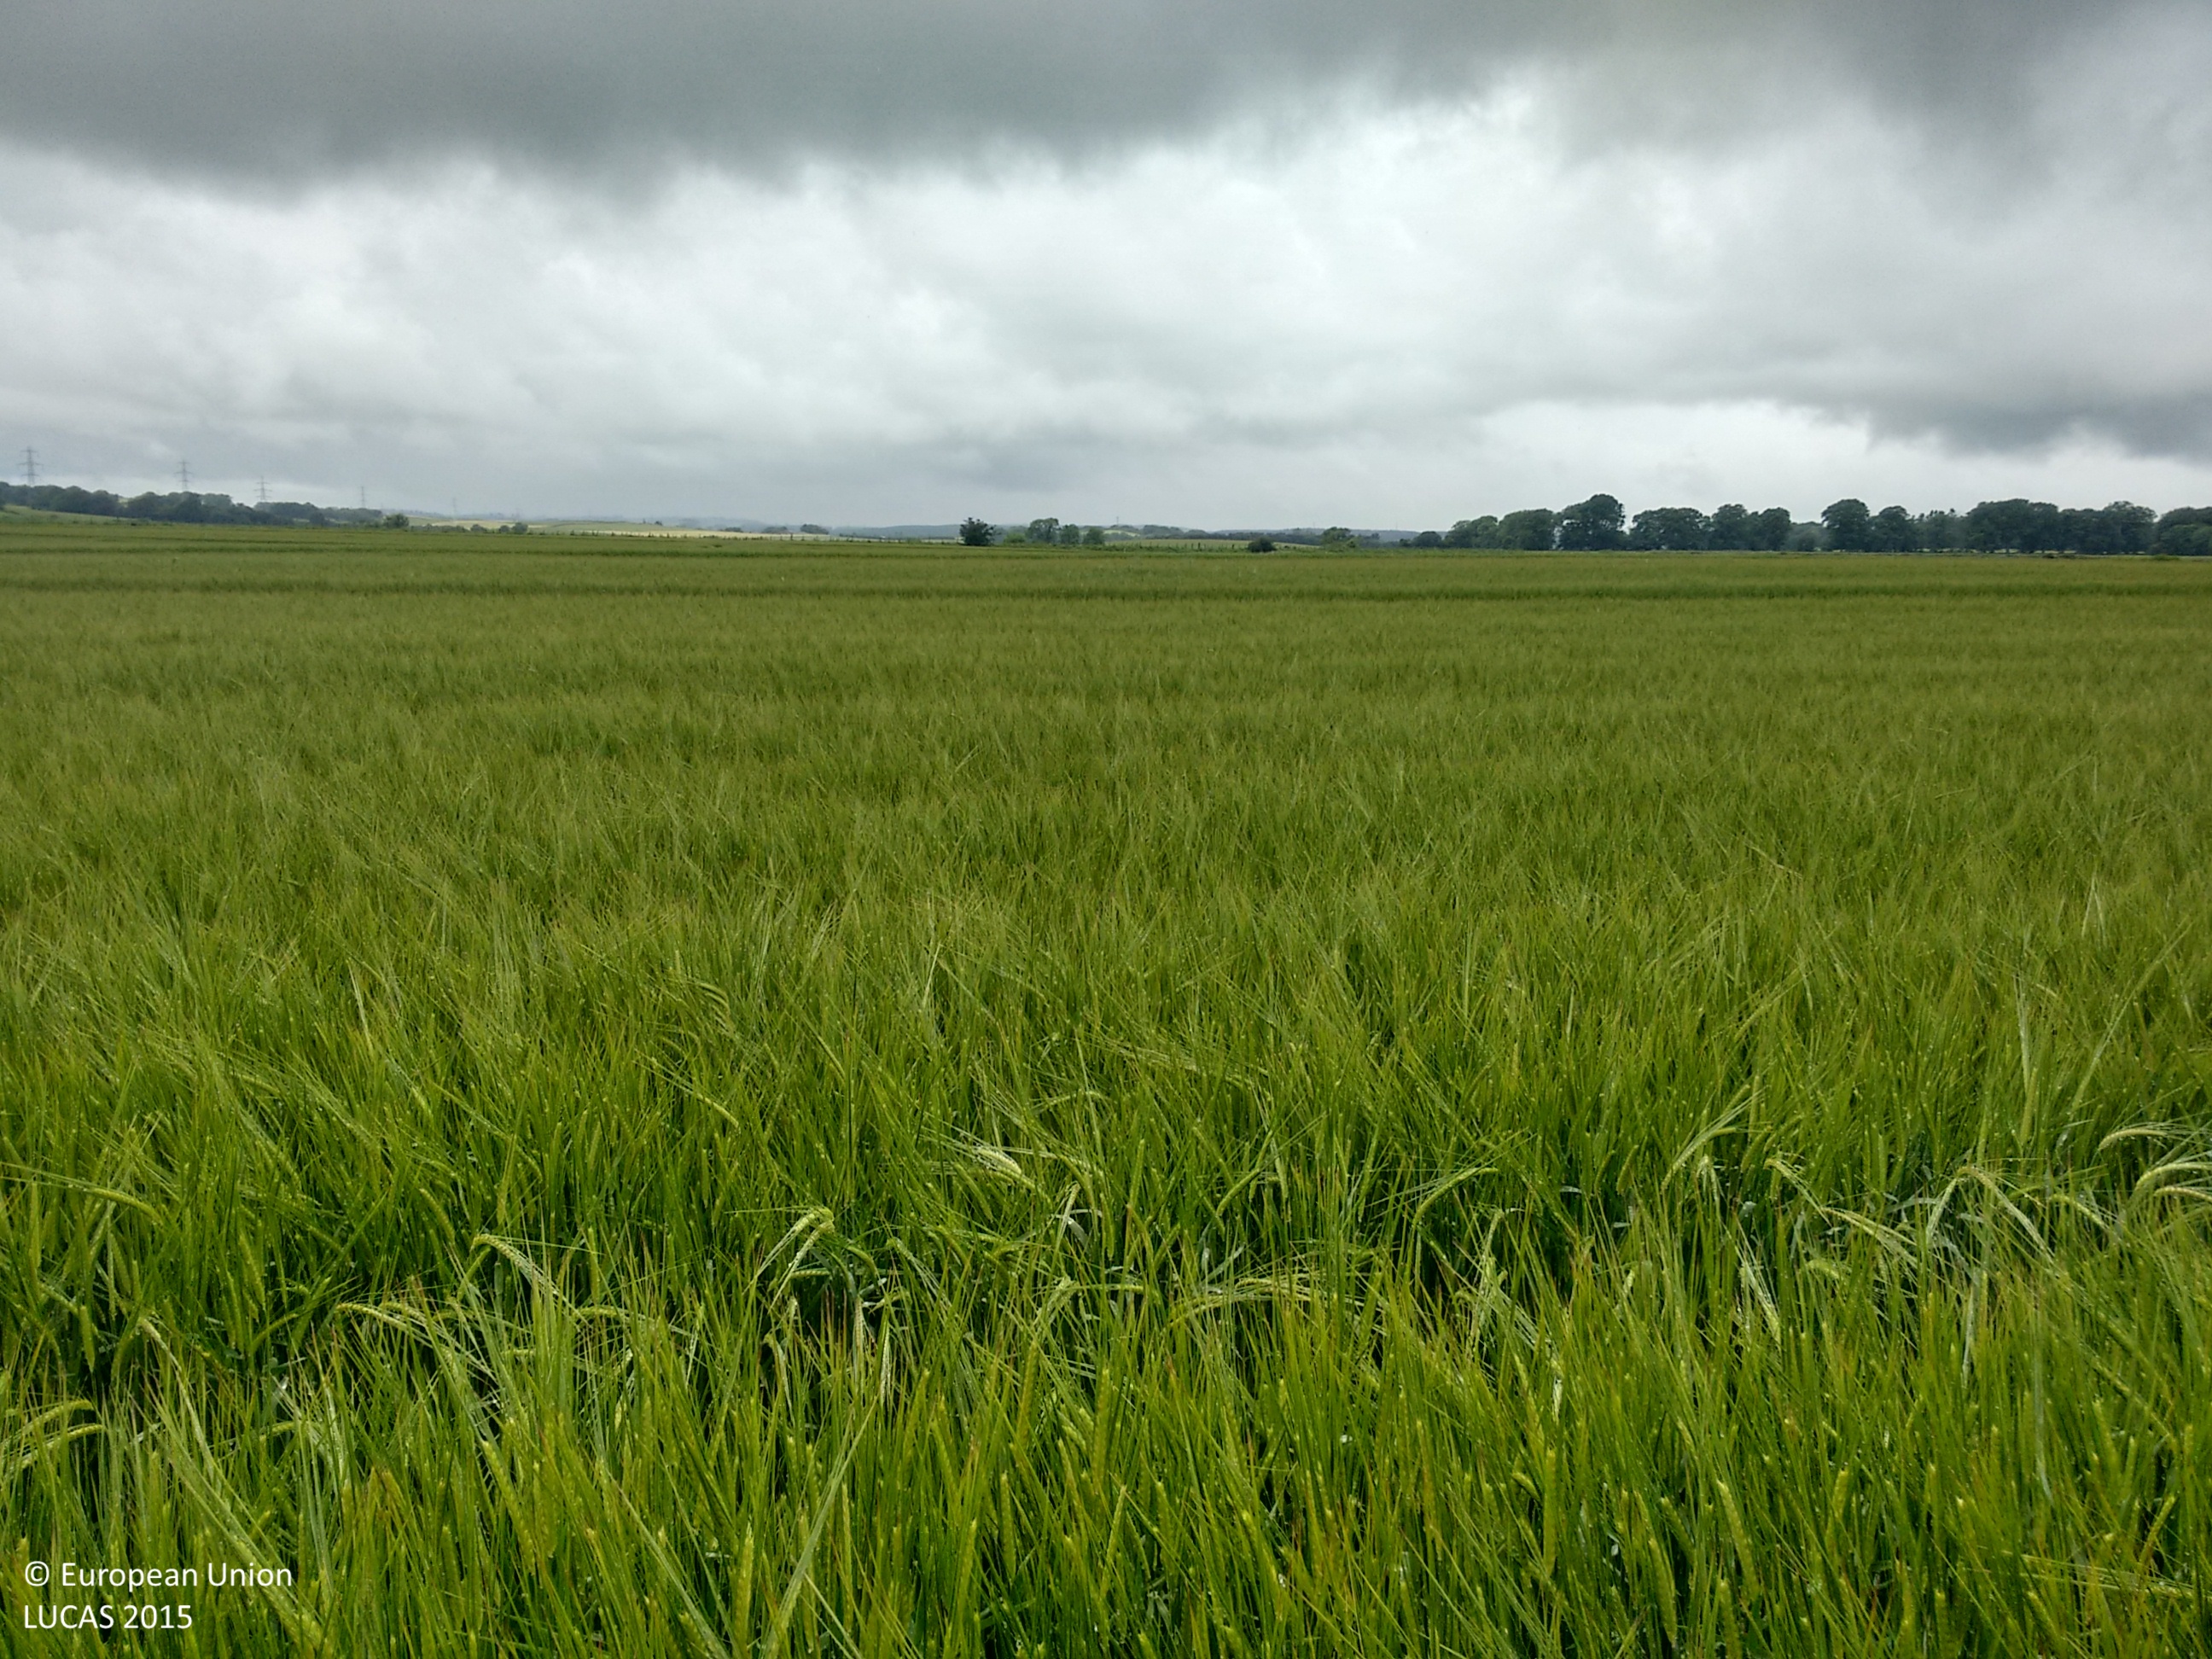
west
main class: Cropland
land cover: Barley
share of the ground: > 75 %
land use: Agriculture (excluding fallow land and kitchen gardens)
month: July
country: GB
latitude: 57.2333
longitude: -2.2934
